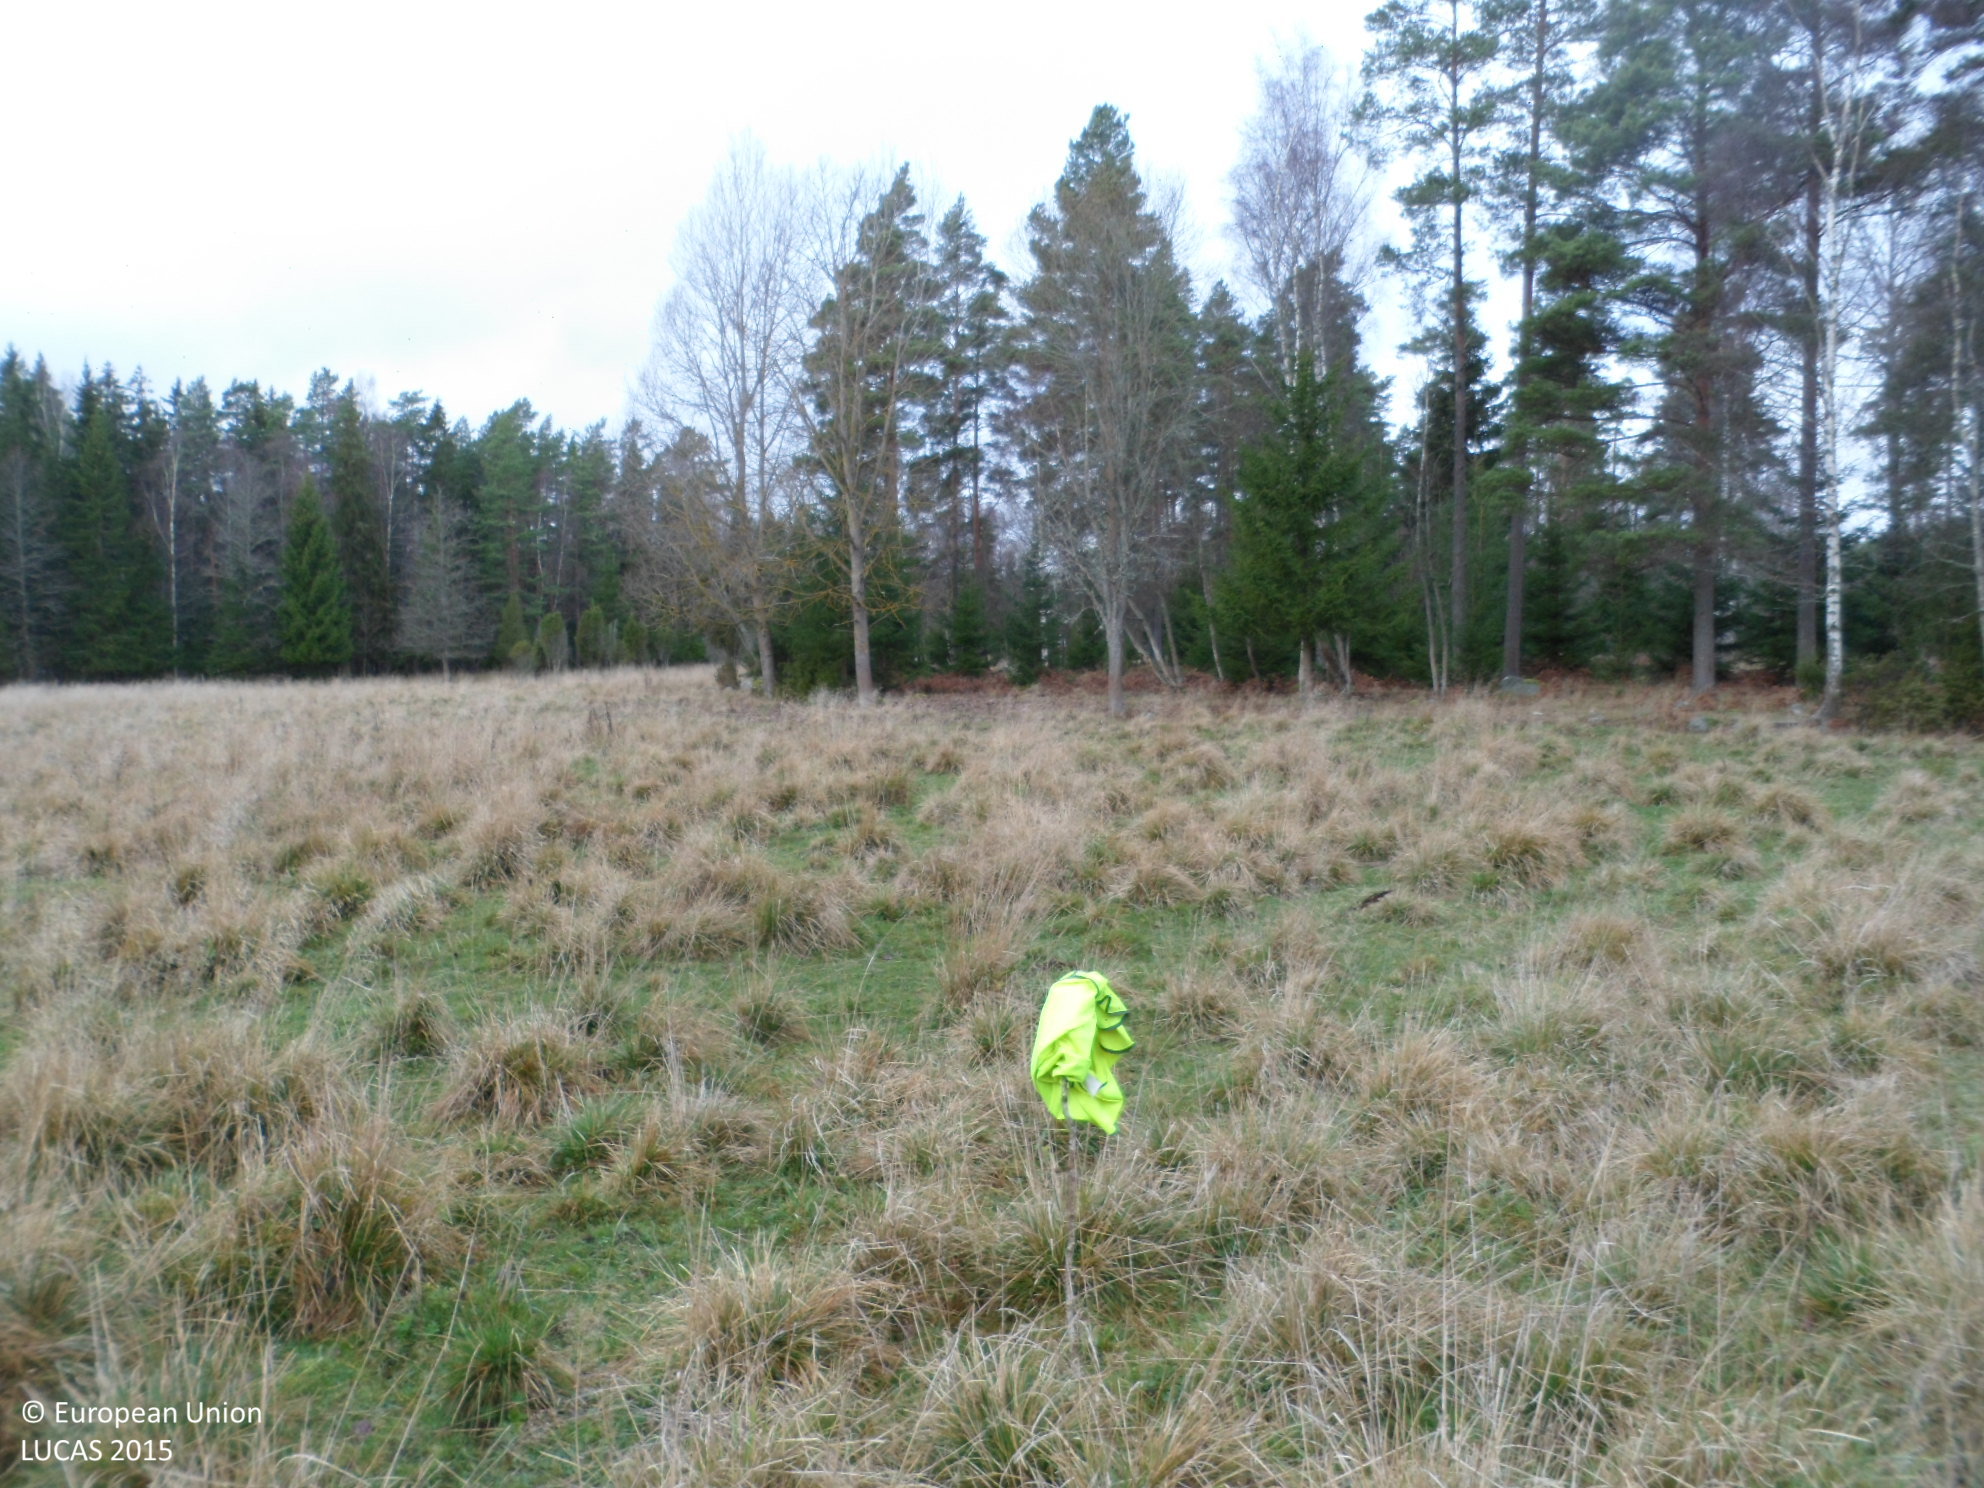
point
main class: Grassland
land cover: Grassland without tree/shrub cover
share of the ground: > 75 %
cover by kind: herbaceous plants 100 %
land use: Agriculture (excluding fallow land and kitchen gardens)
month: November
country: SE
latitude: 57.4774
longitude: 15.8846
